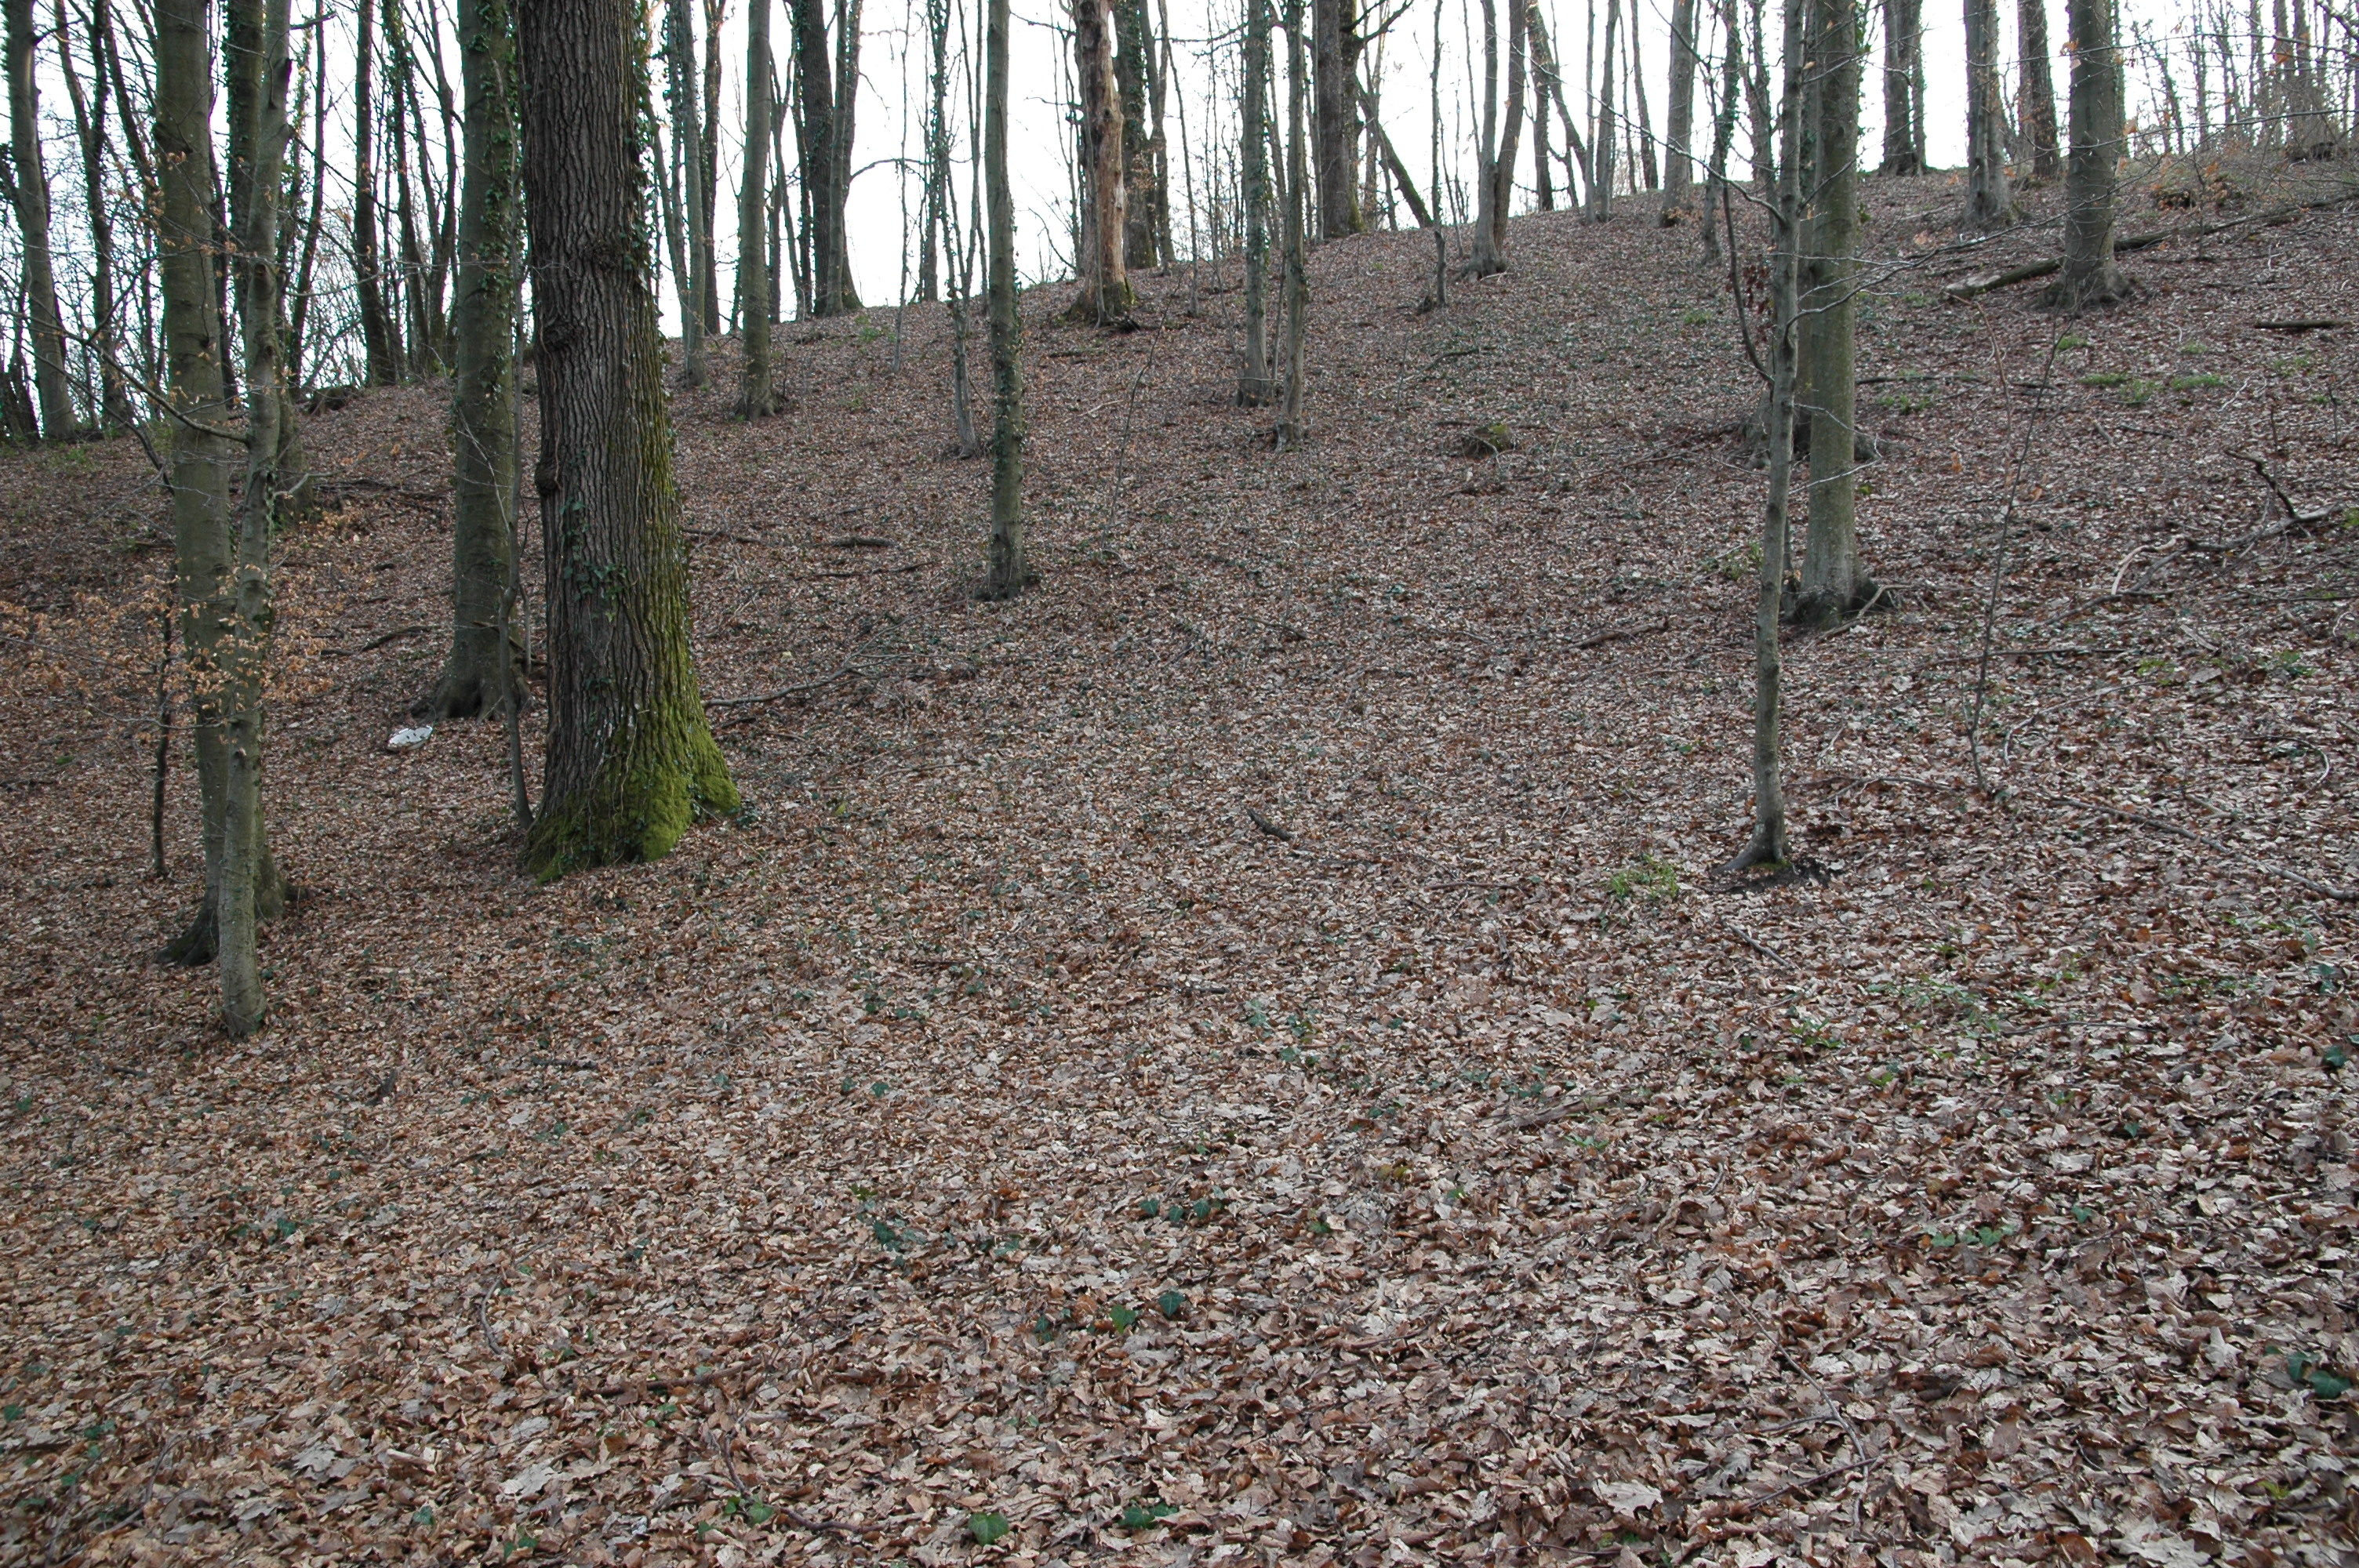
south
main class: Woodland
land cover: Broadleaved woodland
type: beech forest
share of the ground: > 75 %
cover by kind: broadleaved forest trees 90 %, shrubs 5 %, herbaceous plants 5 %
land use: Forestry
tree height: > 5 m
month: March
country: HR
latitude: 46.2397
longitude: 15.9515
